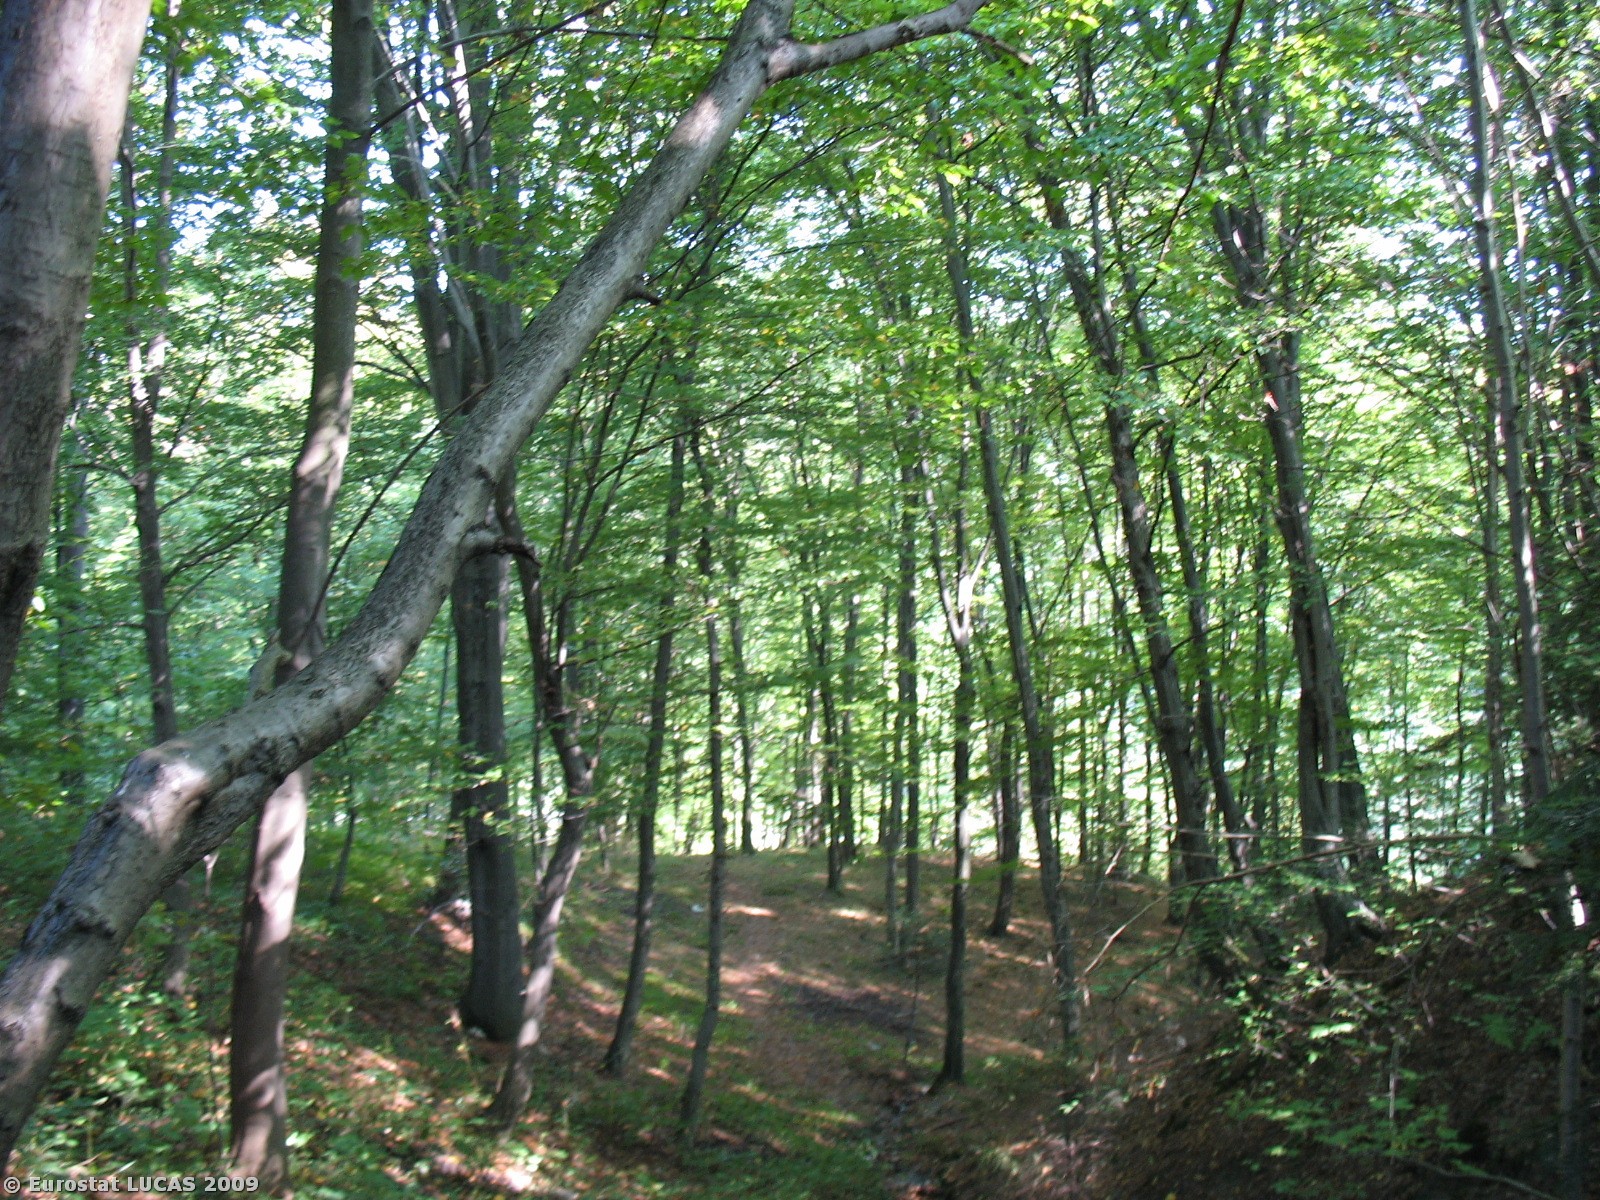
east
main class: Woodland
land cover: Broadleaved woodland
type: mesophytic deciduous forest
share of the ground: > 75 %
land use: Forestry
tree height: > 5 m
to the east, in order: Broadleaved woodland; Rivers and streams; Broadleaved woodland; Shrubland with sparse tree cover; Electric lines; Shrubland with sparse tree cover; Tracks; Spontaneously vegetated surfaces; Grass margins; Tracks; Grass margins; Shrubland without tree cover; Rivers and streams; Mixed woodland
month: September
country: PL
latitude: 49.7893
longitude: 19.6825
